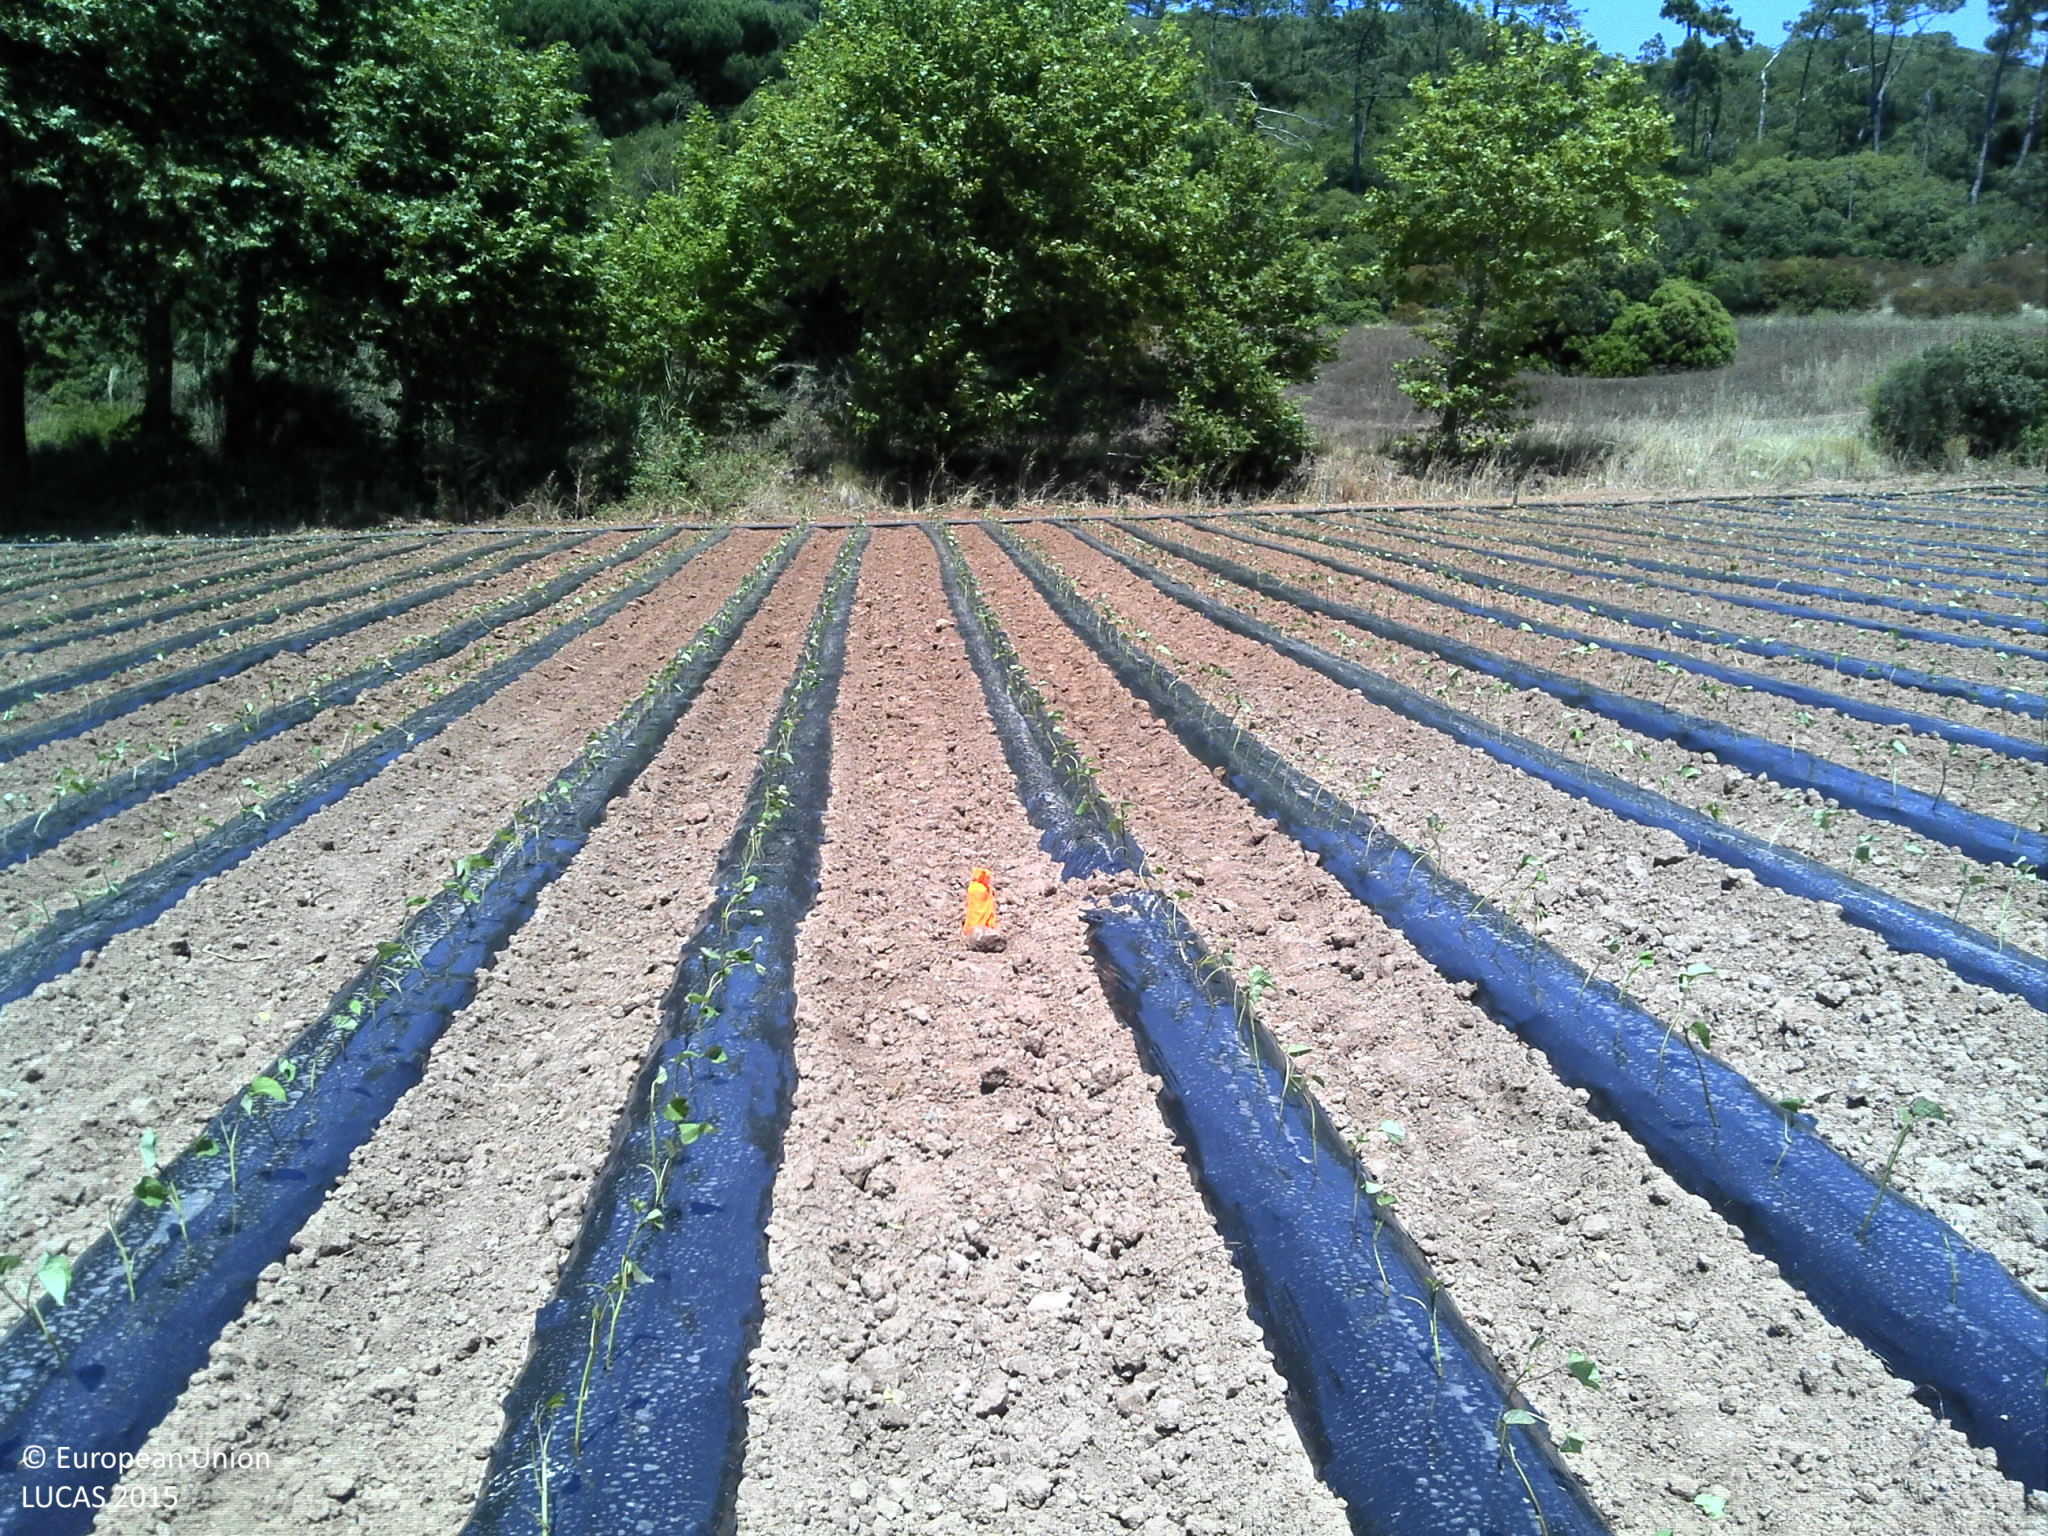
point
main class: Cropland
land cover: Other root crops
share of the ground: 10 - 25 %
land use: Agriculture (excluding fallow land and kitchen gardens)
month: June
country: PT
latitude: 39.1750
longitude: -9.3401
